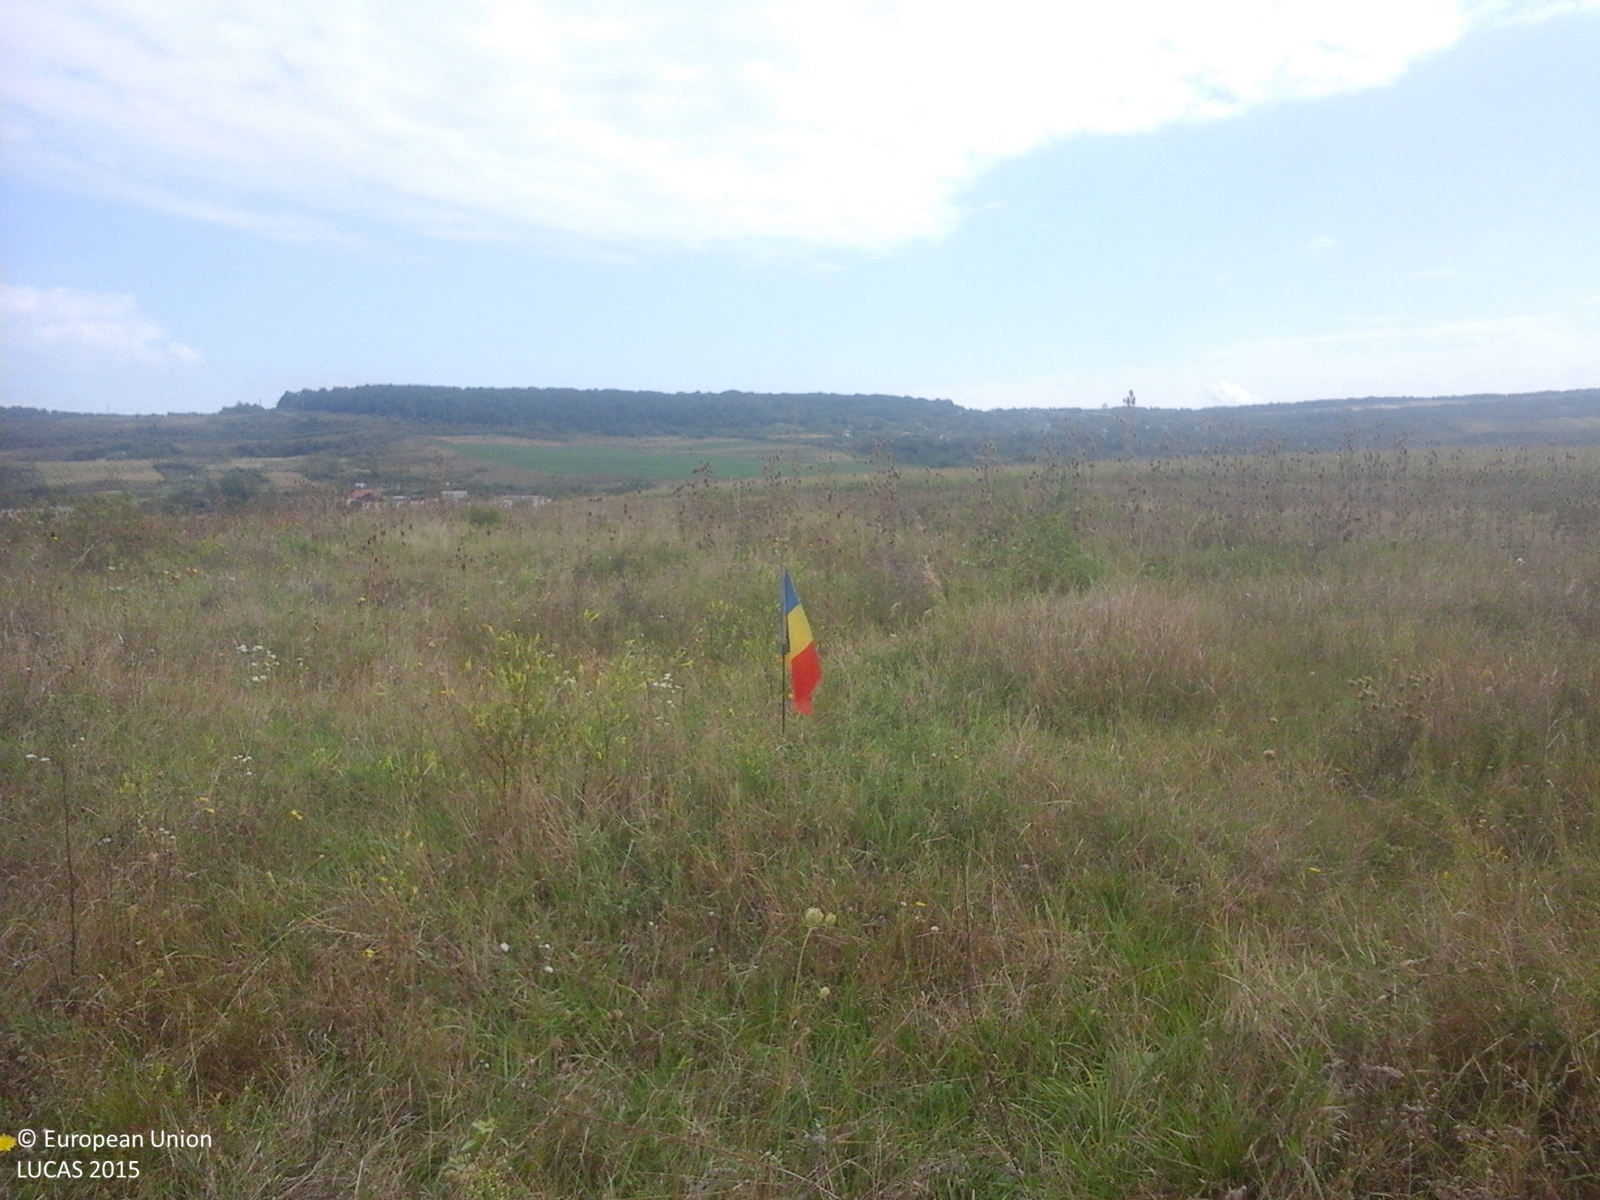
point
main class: Grassland
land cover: Spontaneously vegetated surfaces
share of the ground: > 75 %
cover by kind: herbaceous plants 100 %
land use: Fallow land
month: September
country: RO
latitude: 47.3629
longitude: 22.8122
